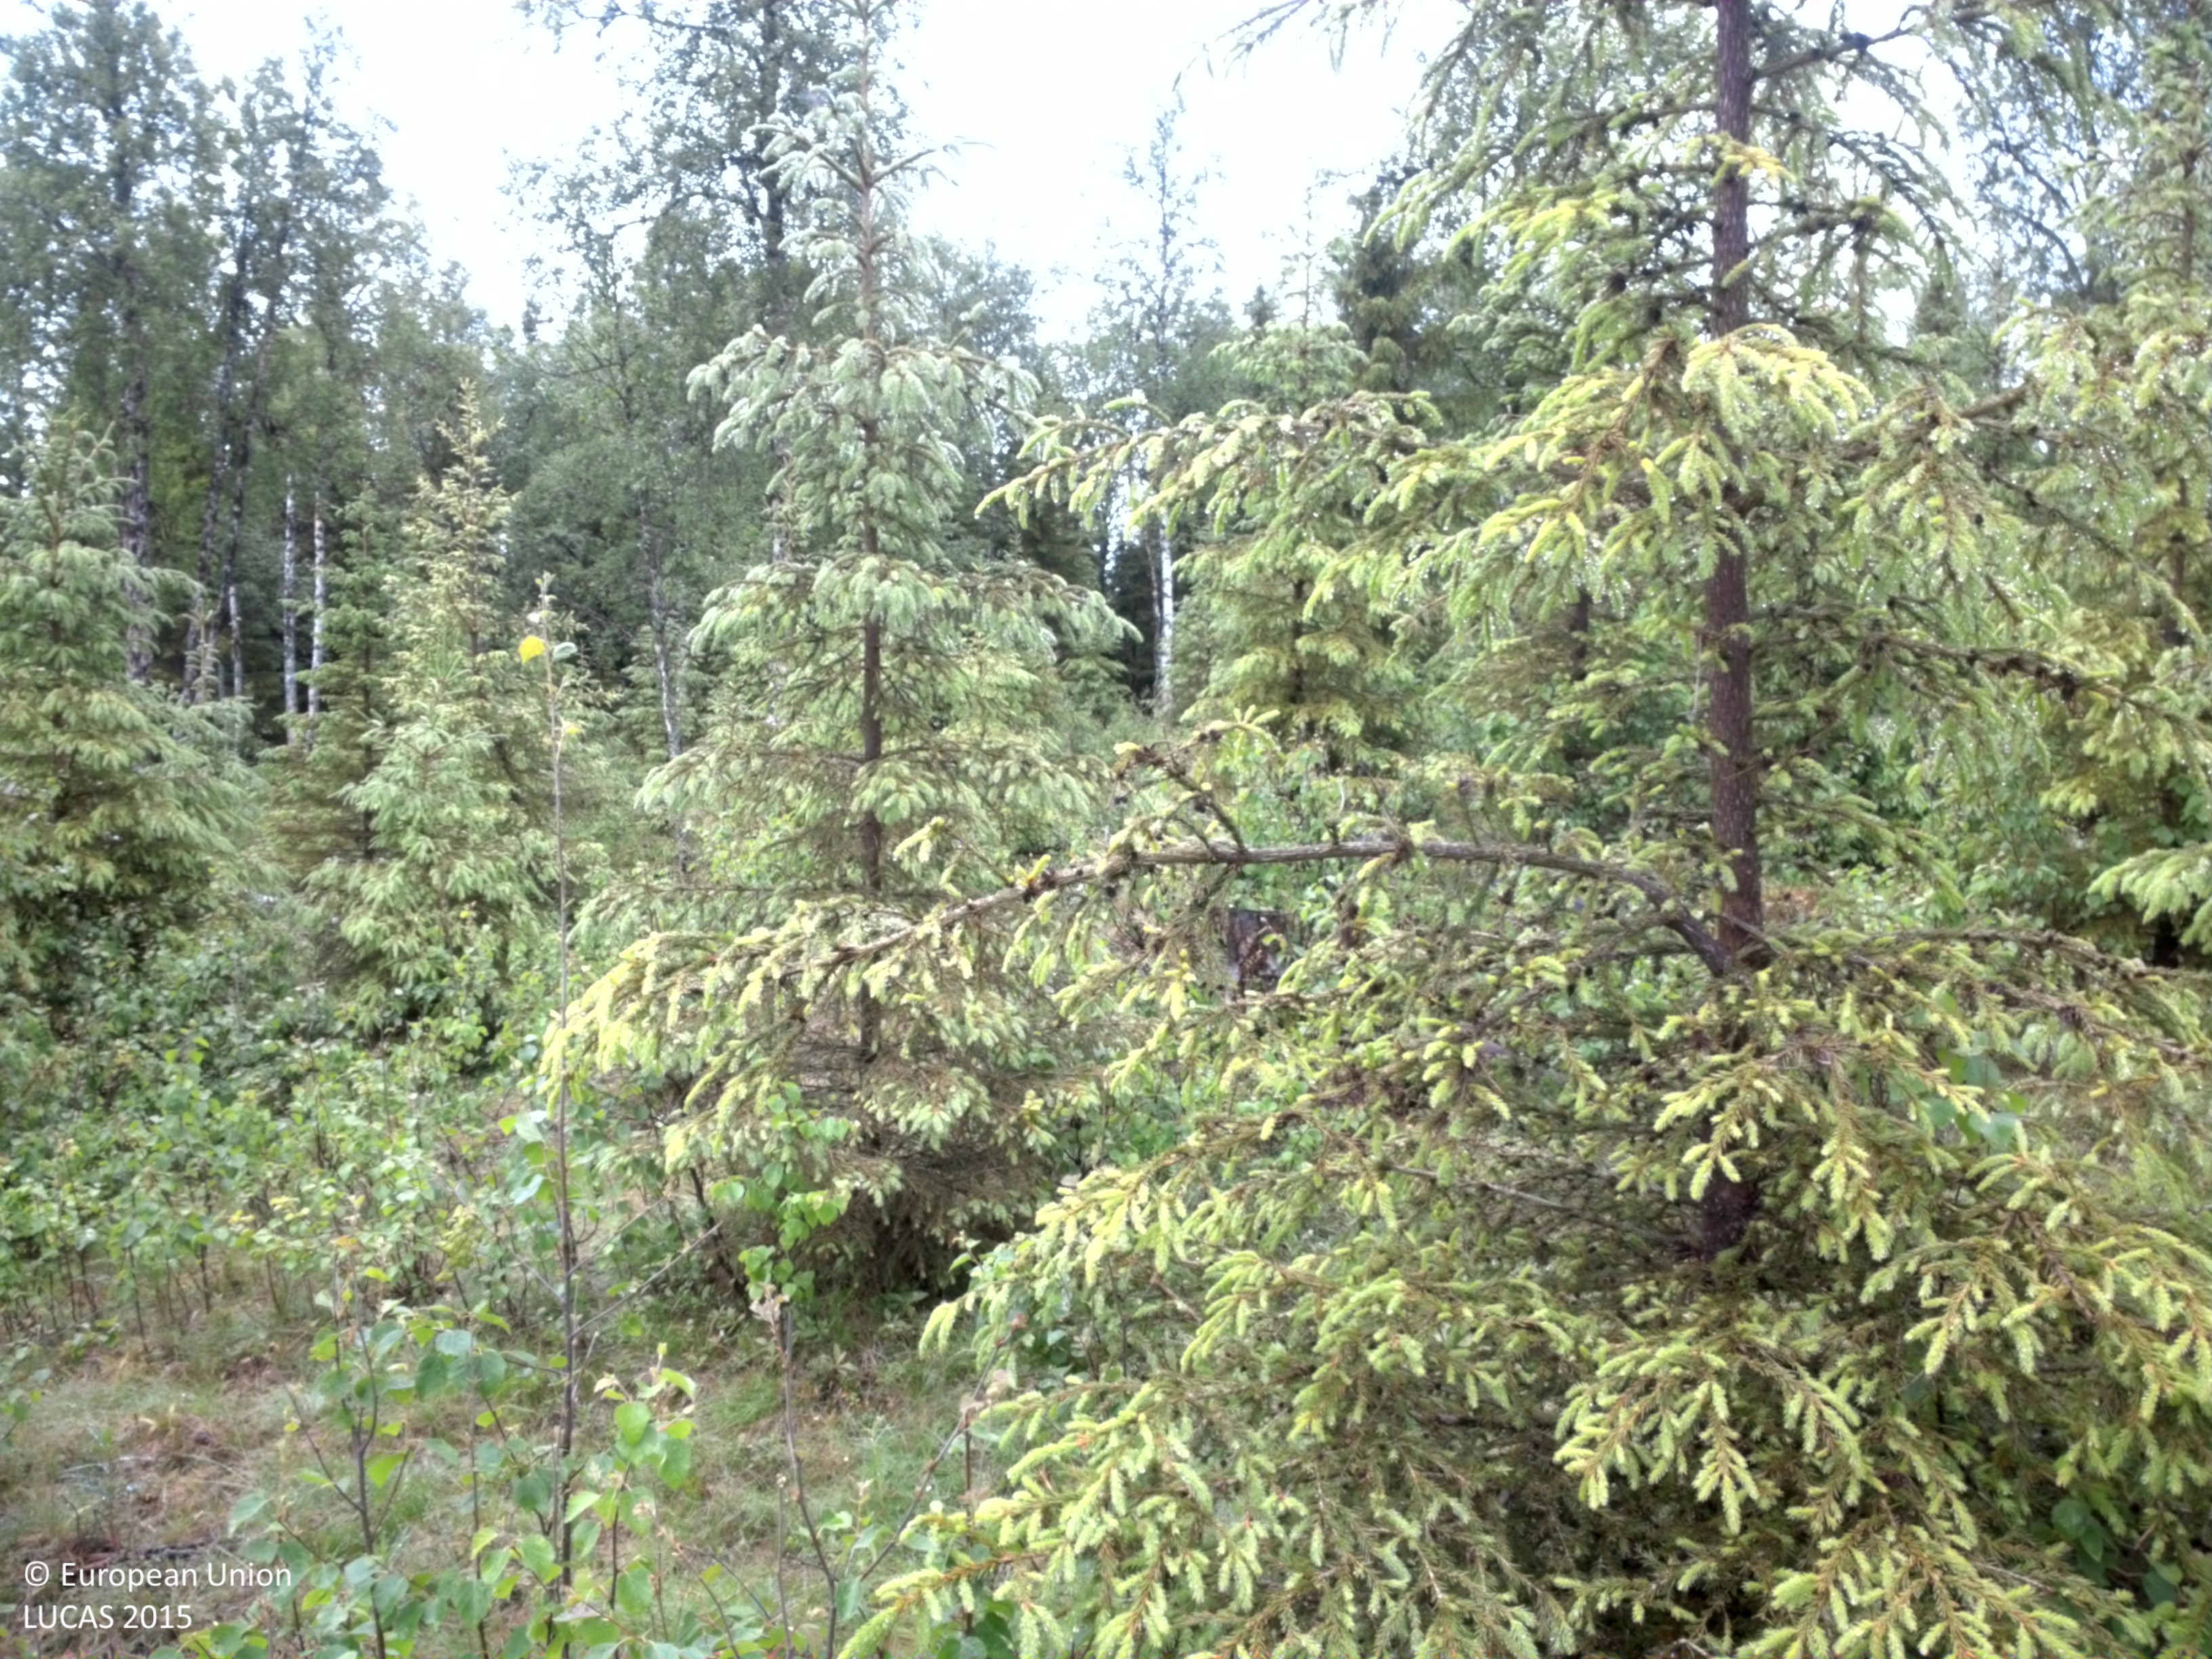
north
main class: Woodland
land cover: Spruce dominated mixed woodland
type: boreal forest
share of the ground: 50 - 75 %
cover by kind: coniferous forest trees 45 %, herbaceous plants 20 %, broadleaved forest trees 15 %, shrubs 15 %, lichens and mosses 5 %
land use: Forestry
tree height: > 5 m
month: July
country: SE
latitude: 64.3573
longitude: 18.3985
